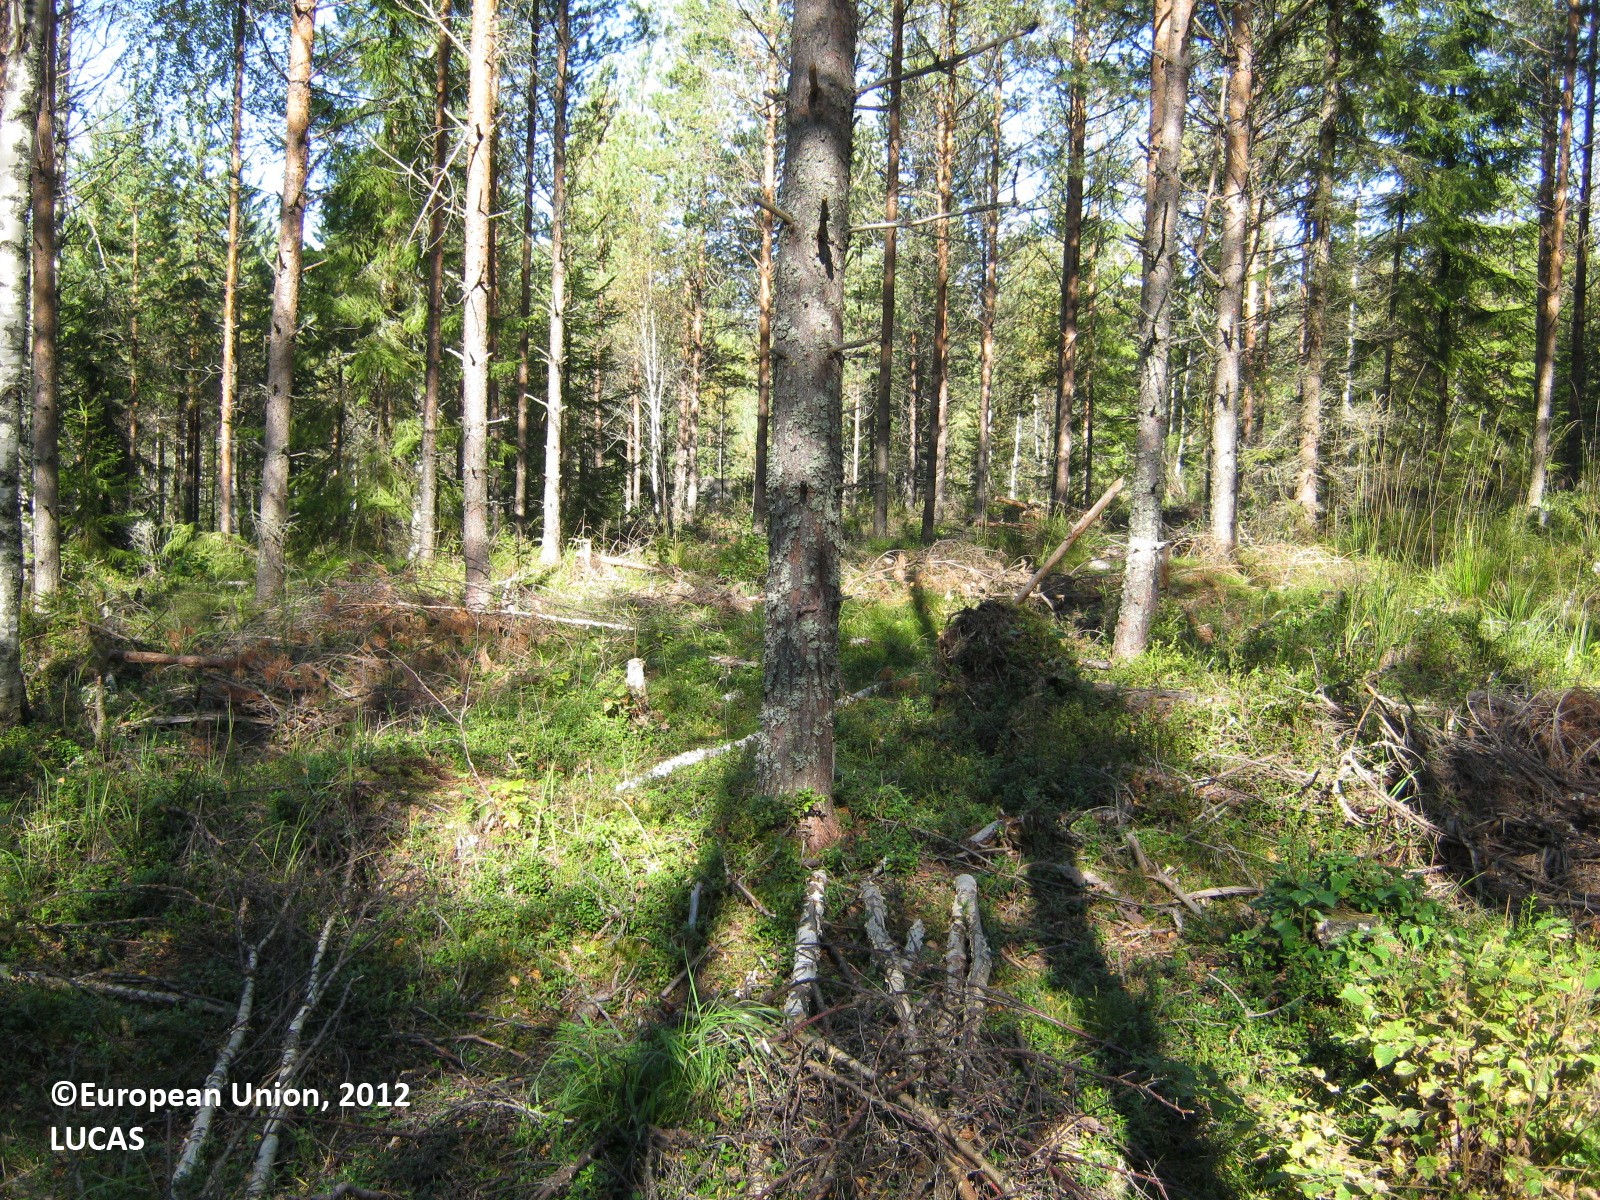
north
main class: Woodland
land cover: Pine dominated coniferous woodland
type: boreal forest
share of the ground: > 75 %
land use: Forestry
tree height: > 5 m
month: September
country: FI
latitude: 60.9535
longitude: 27.8647
